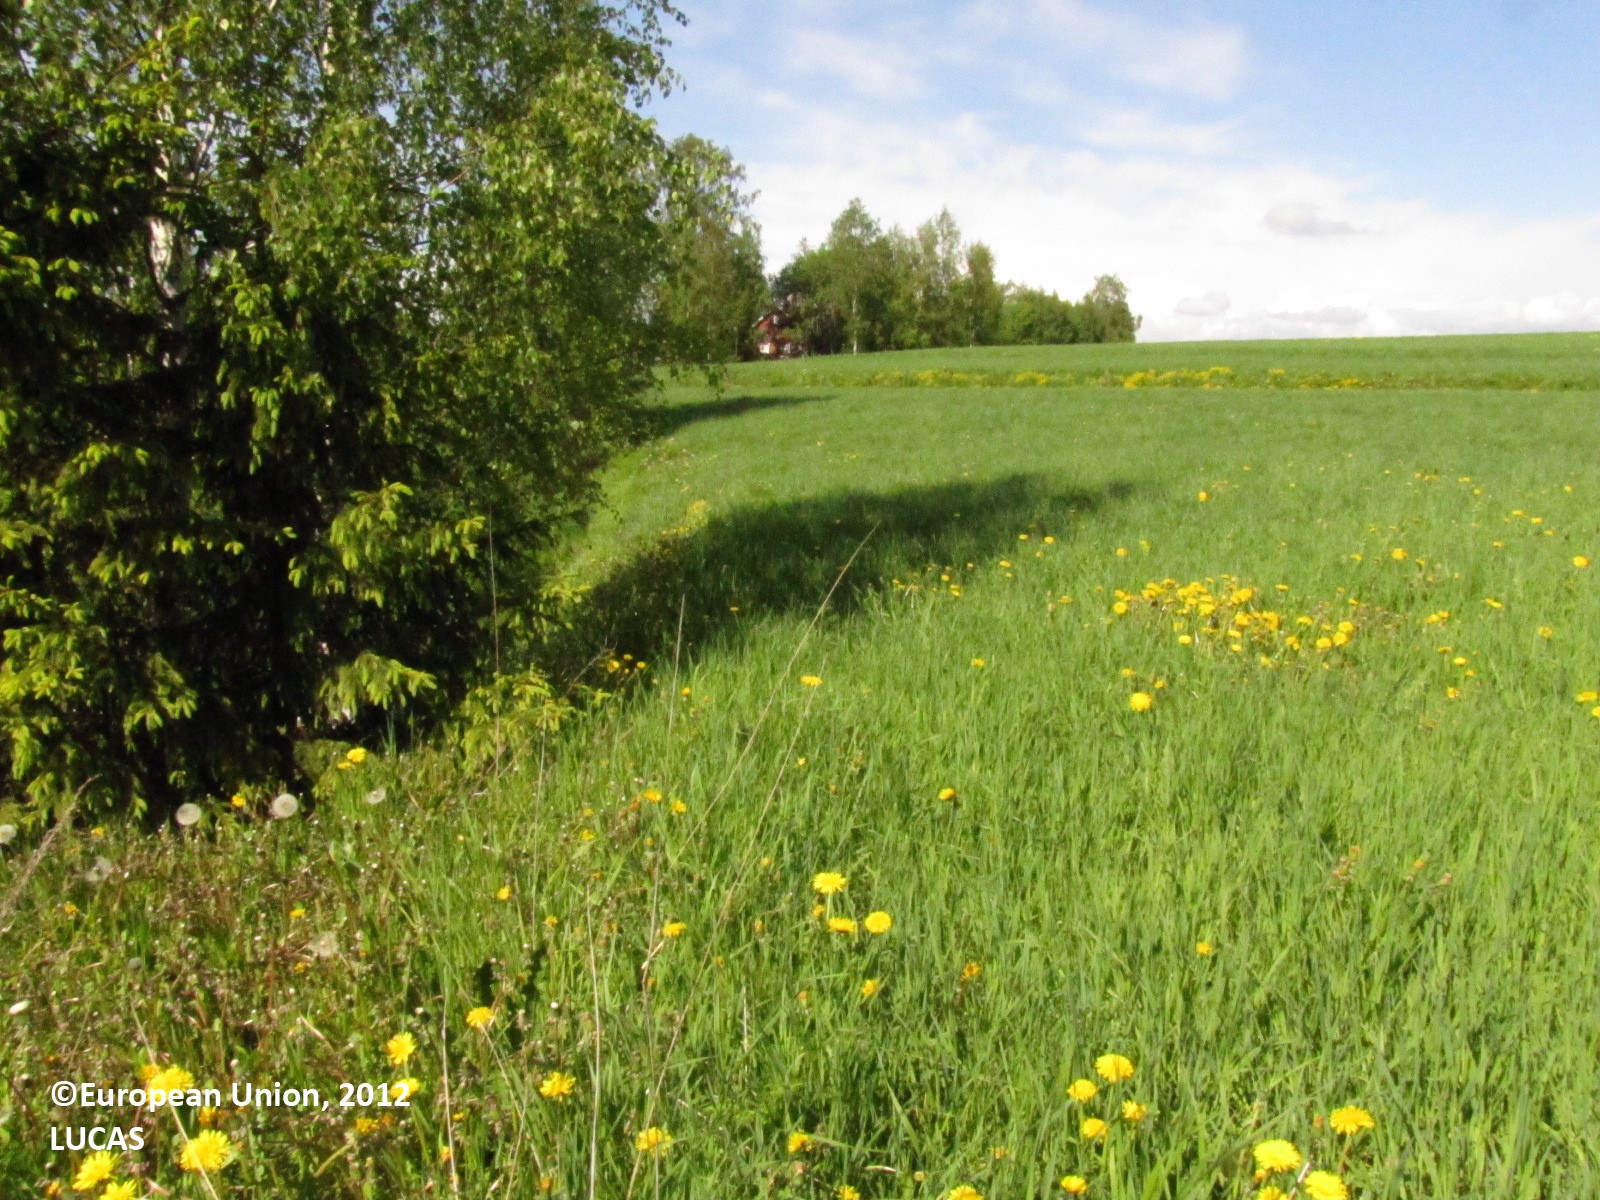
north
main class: Cropland
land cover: Temporary grasslands
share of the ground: > 75 %
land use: Agriculture (excluding fallow land and kitchen gardens)
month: June
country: FI
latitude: 61.5592
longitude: 23.1164
